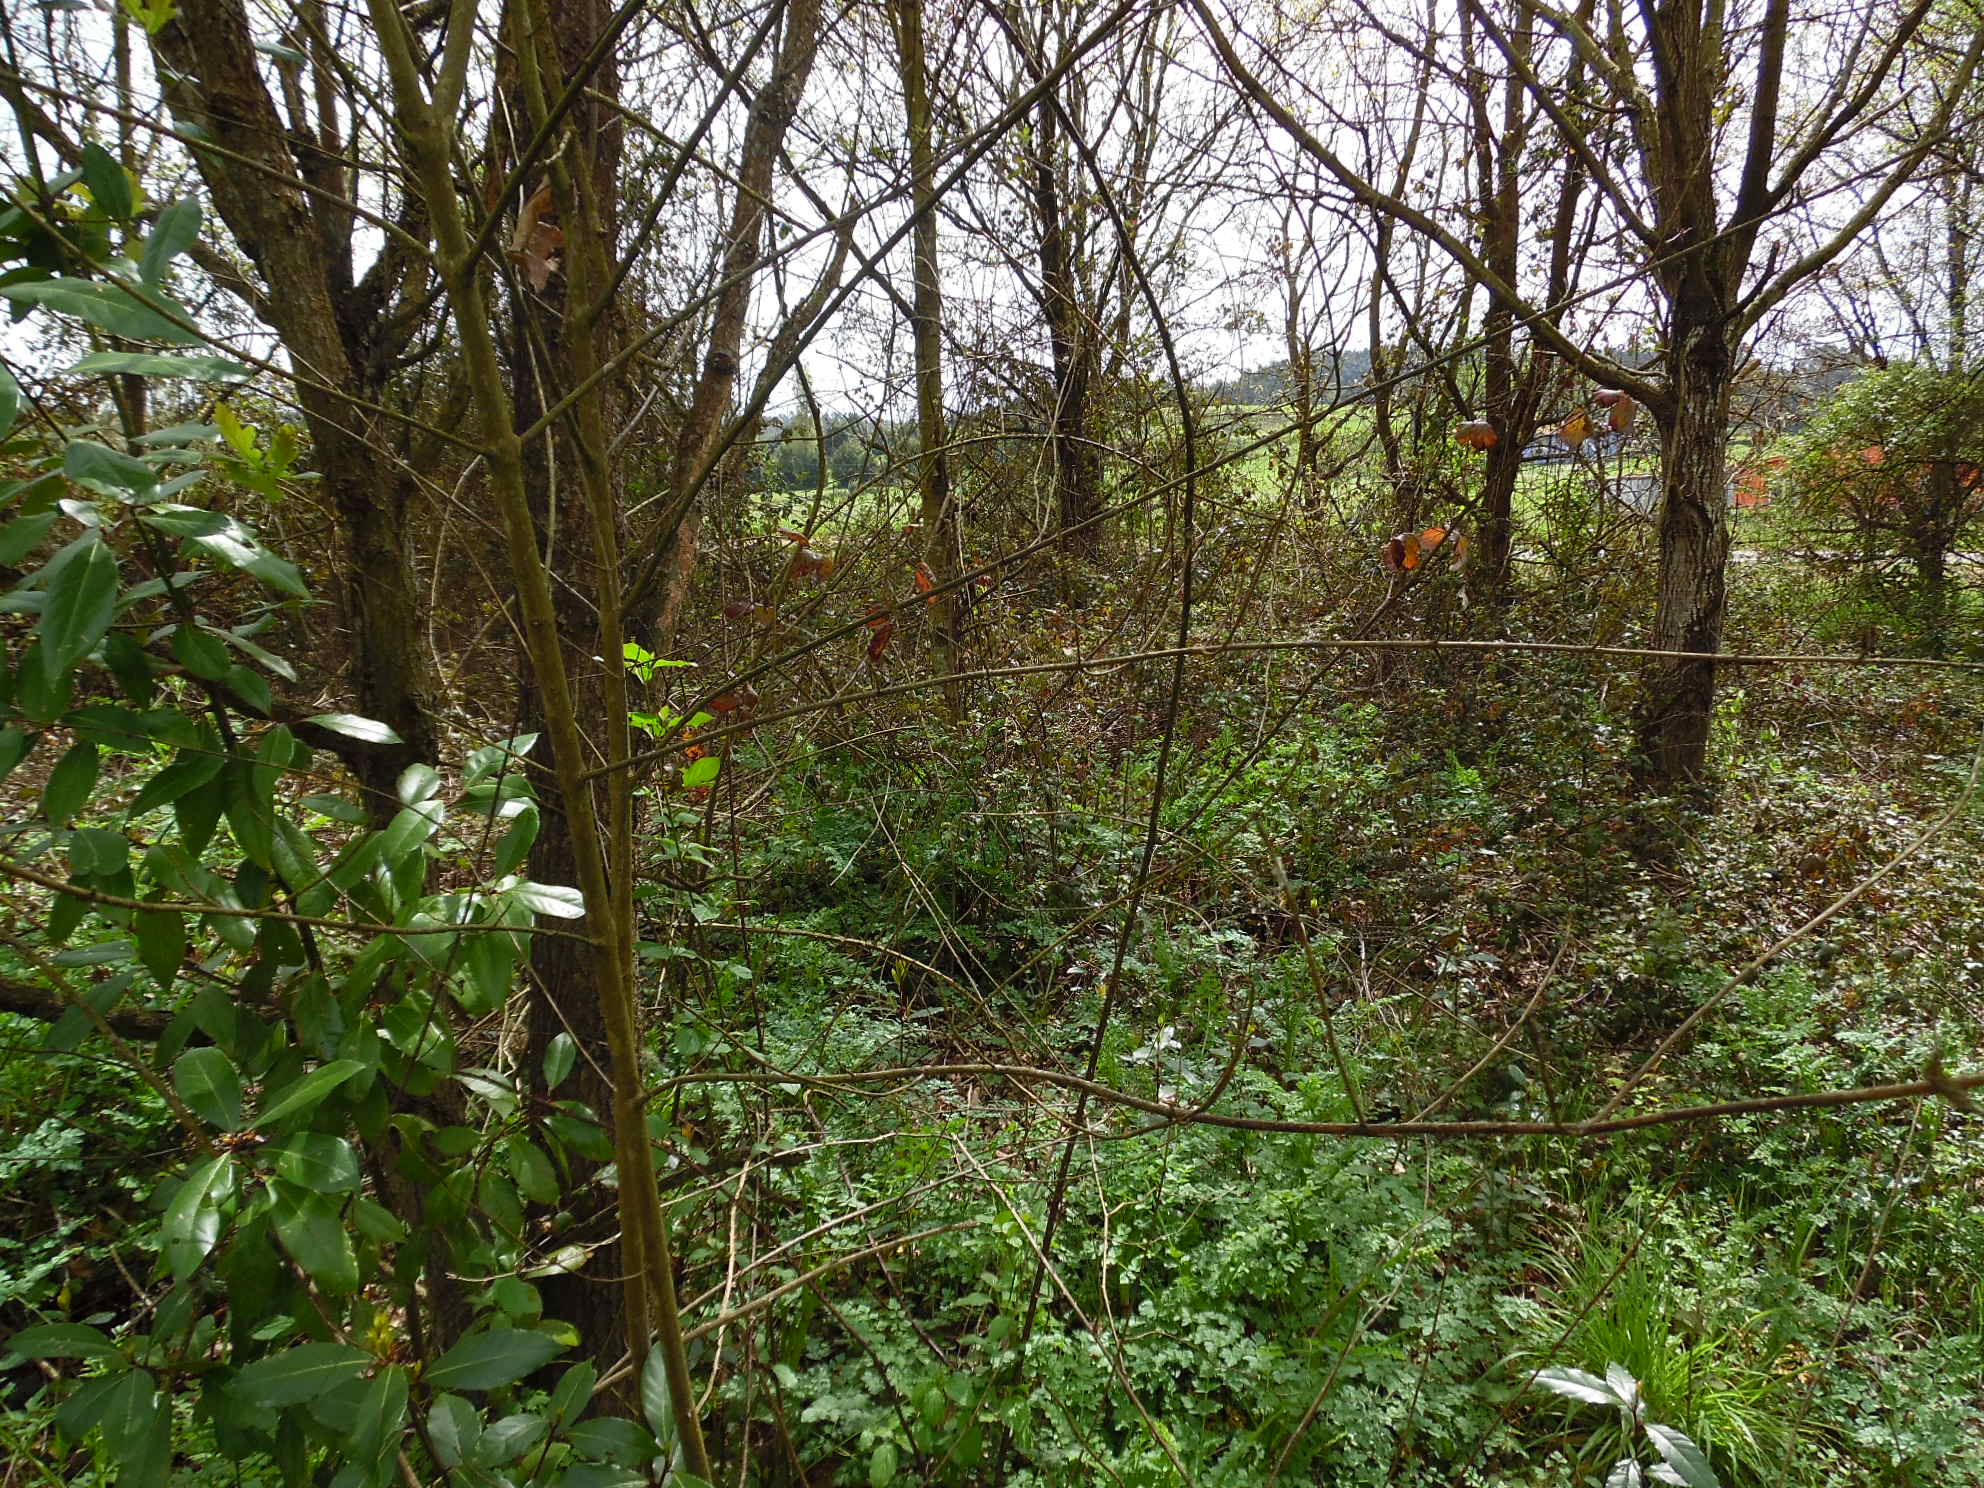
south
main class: Woodland
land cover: Broadleaved woodland
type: floodplain forest
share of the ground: > 75 %
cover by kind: broadleaved forest trees 90 %, shrubs 5 %, herbaceous plants 5 %
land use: Semi-natural and natural areas not in use
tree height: > 5 m
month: April
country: ES
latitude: 43.5245
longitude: -5.8648
